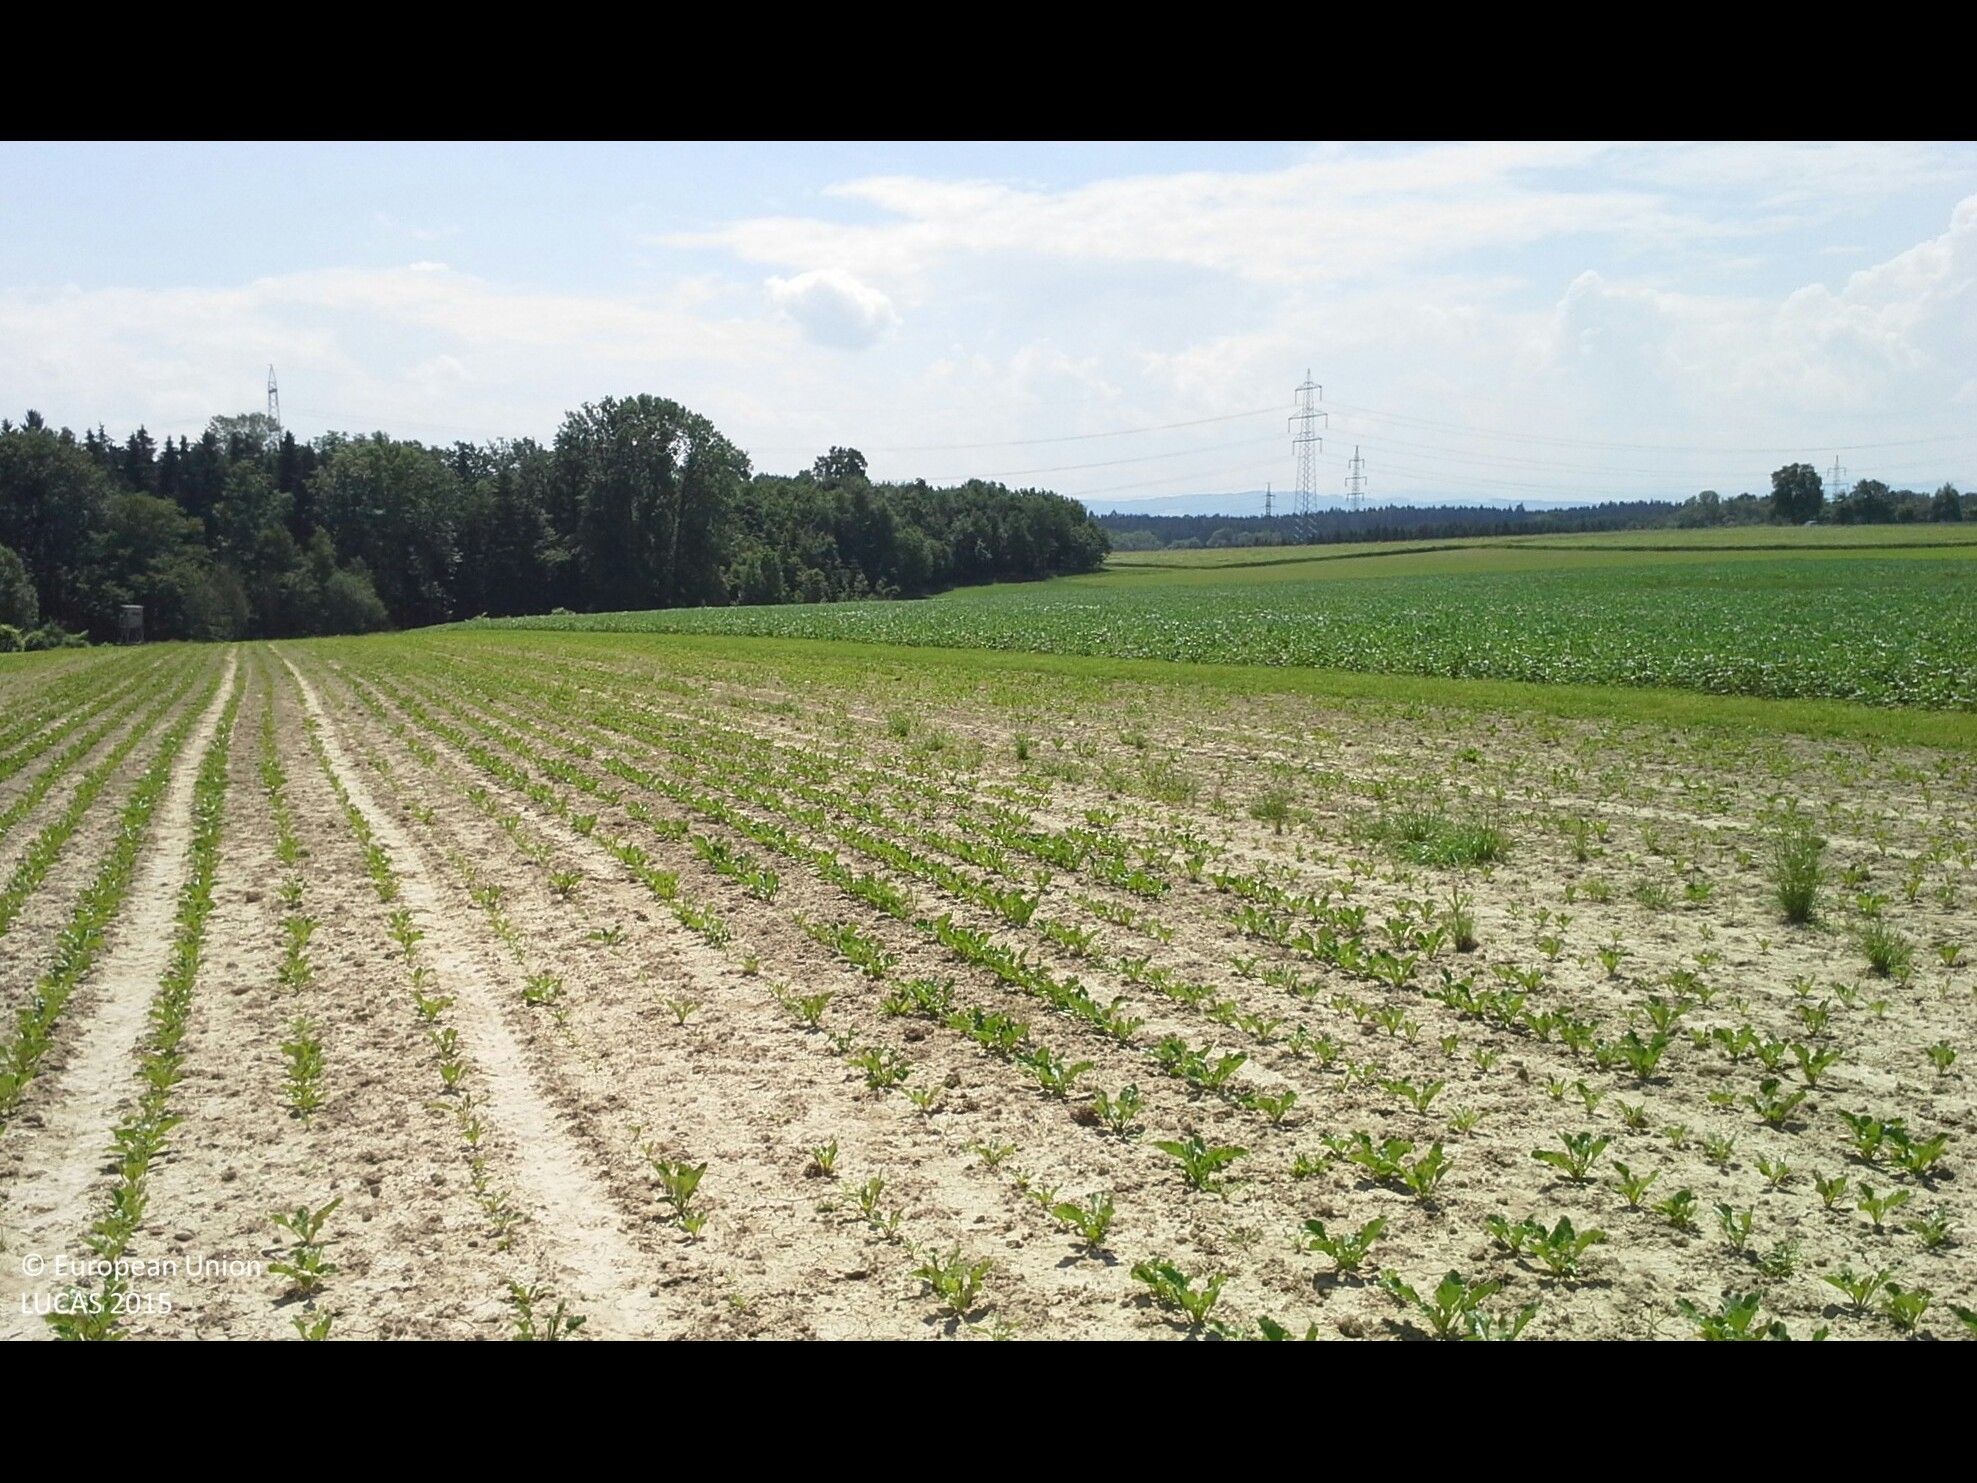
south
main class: Cropland
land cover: Sugar beet
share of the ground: 10 - 25 %
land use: Agriculture (excluding fallow land and kitchen gardens)
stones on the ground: < 10 %
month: June
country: AT
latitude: 48.1317
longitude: 14.5015
